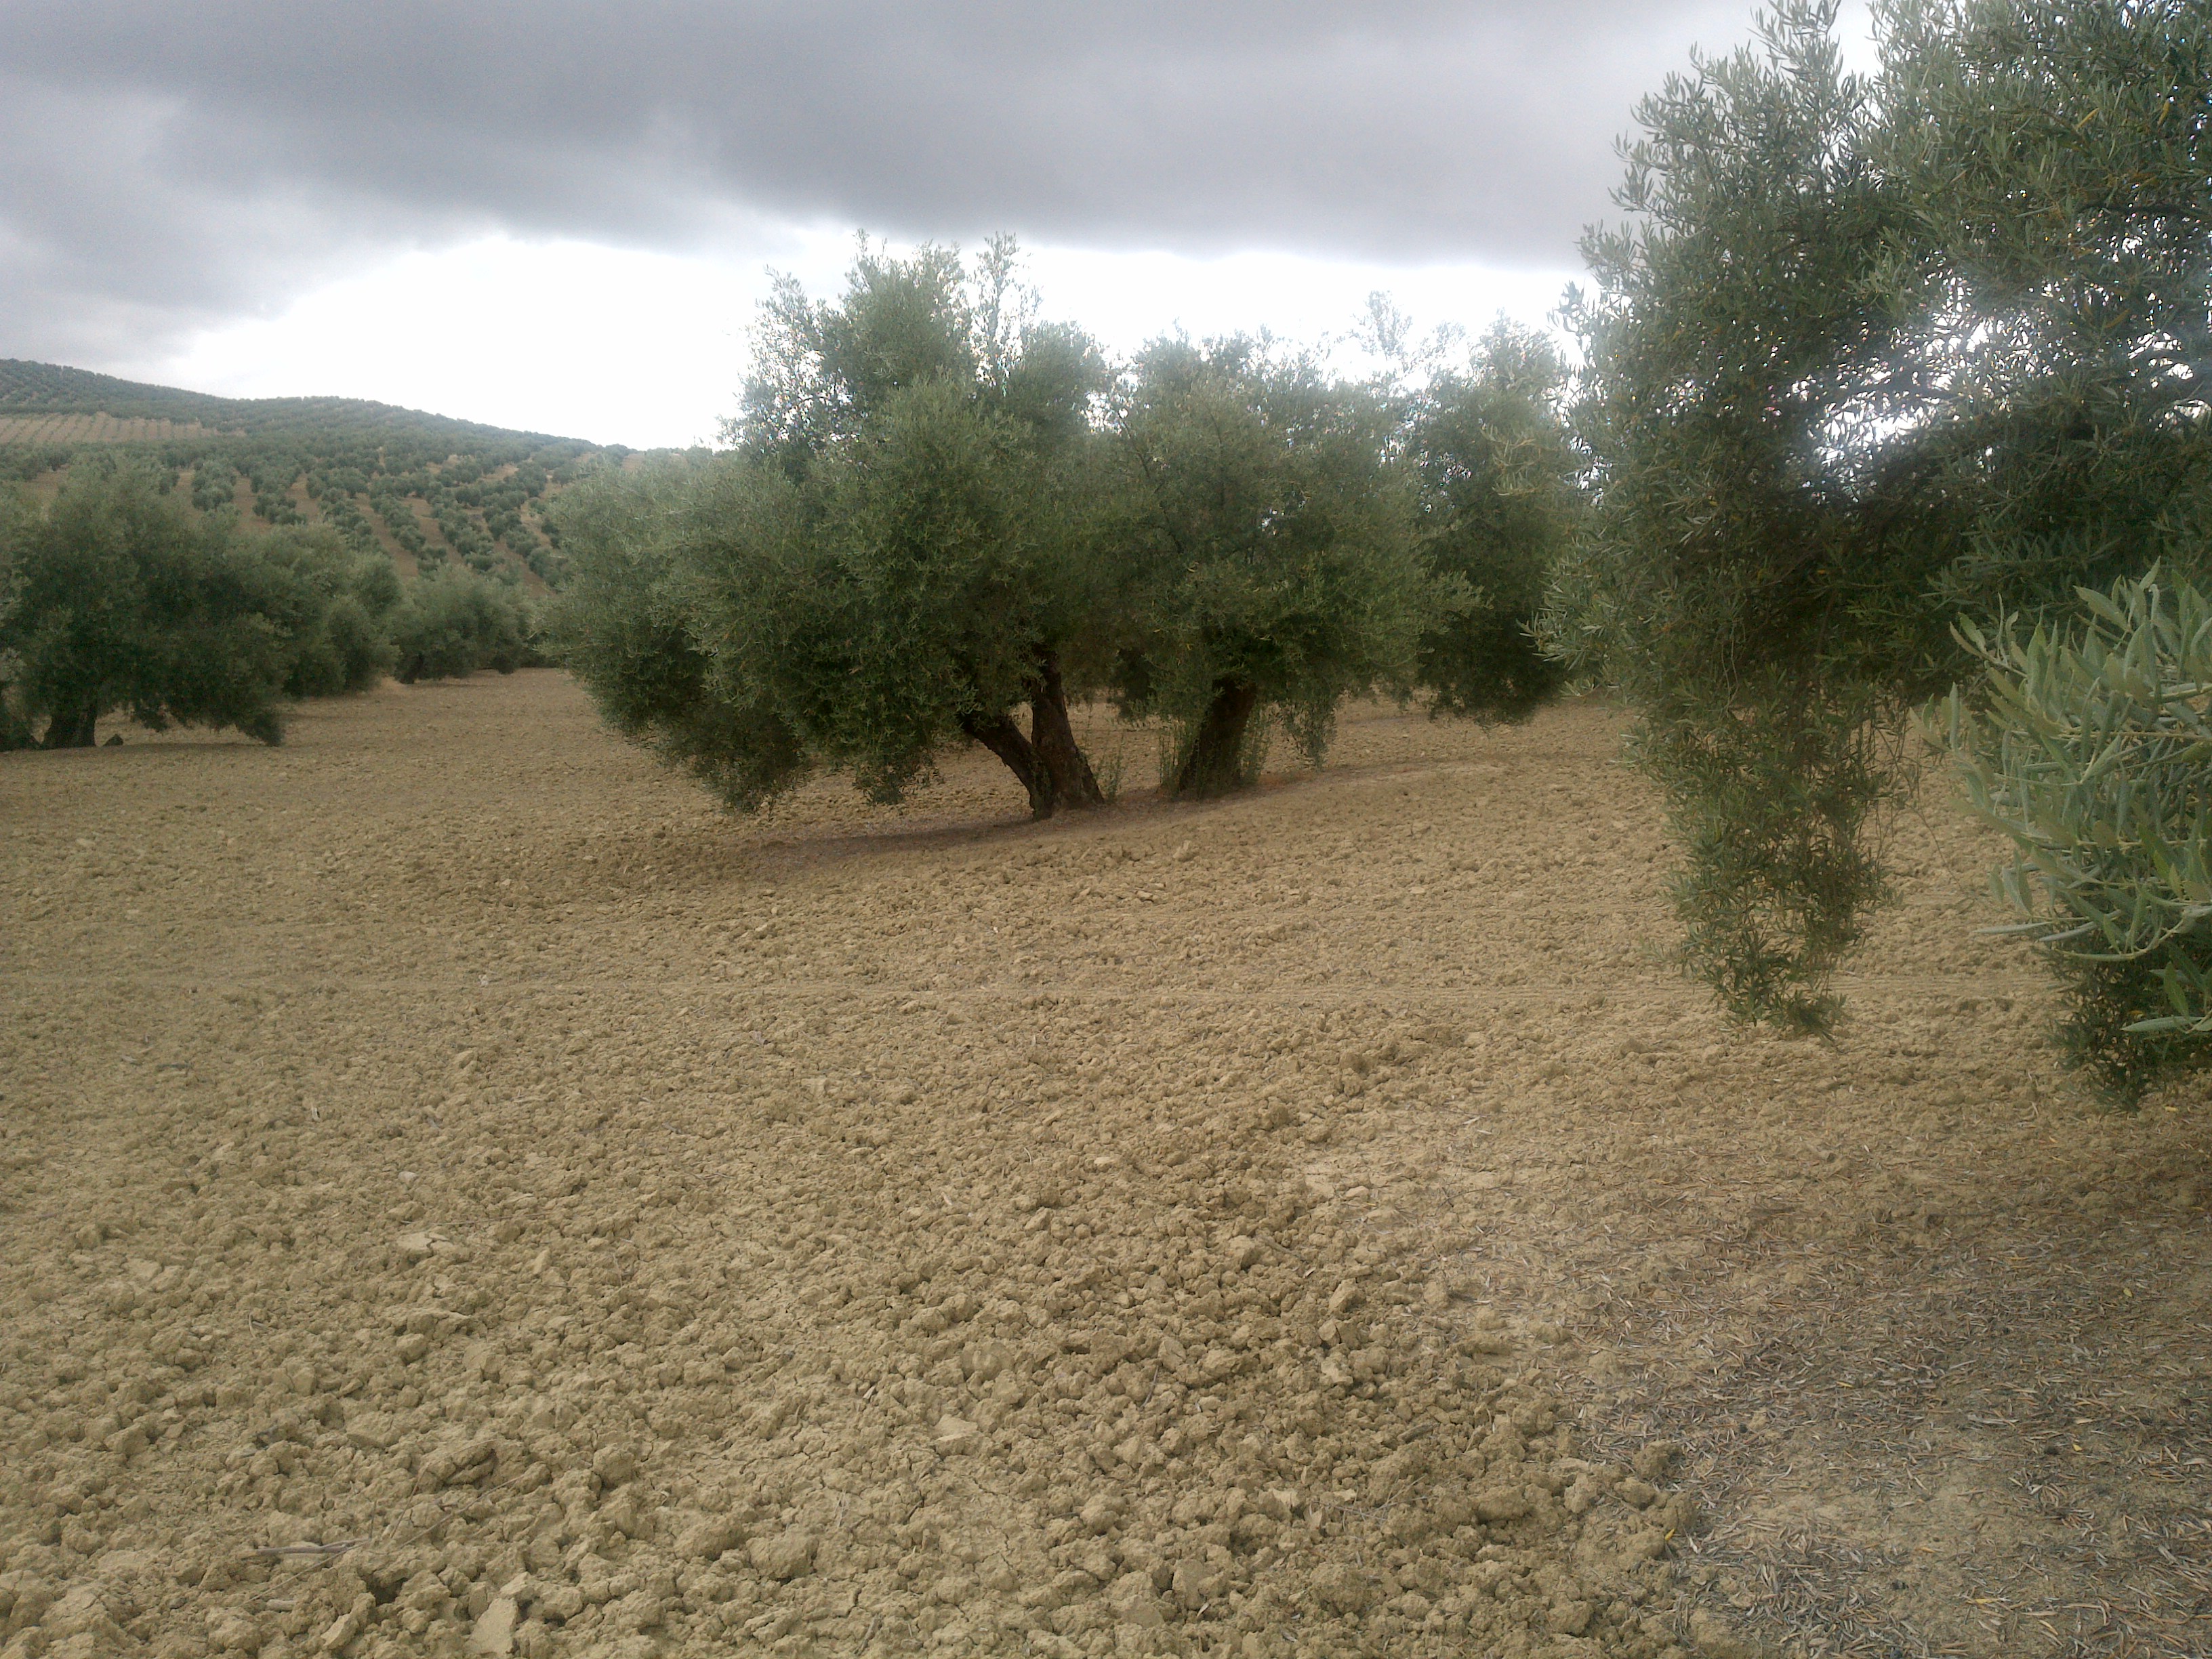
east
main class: Cropland
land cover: Olive groves
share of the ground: 50 - 75 %
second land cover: Other bare soil
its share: > 75 %
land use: Agriculture (excluding fallow land and kitchen gardens)
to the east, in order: Olive groves; Other bare soil
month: June
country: ES
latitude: 37.8918
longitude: -4.3020
